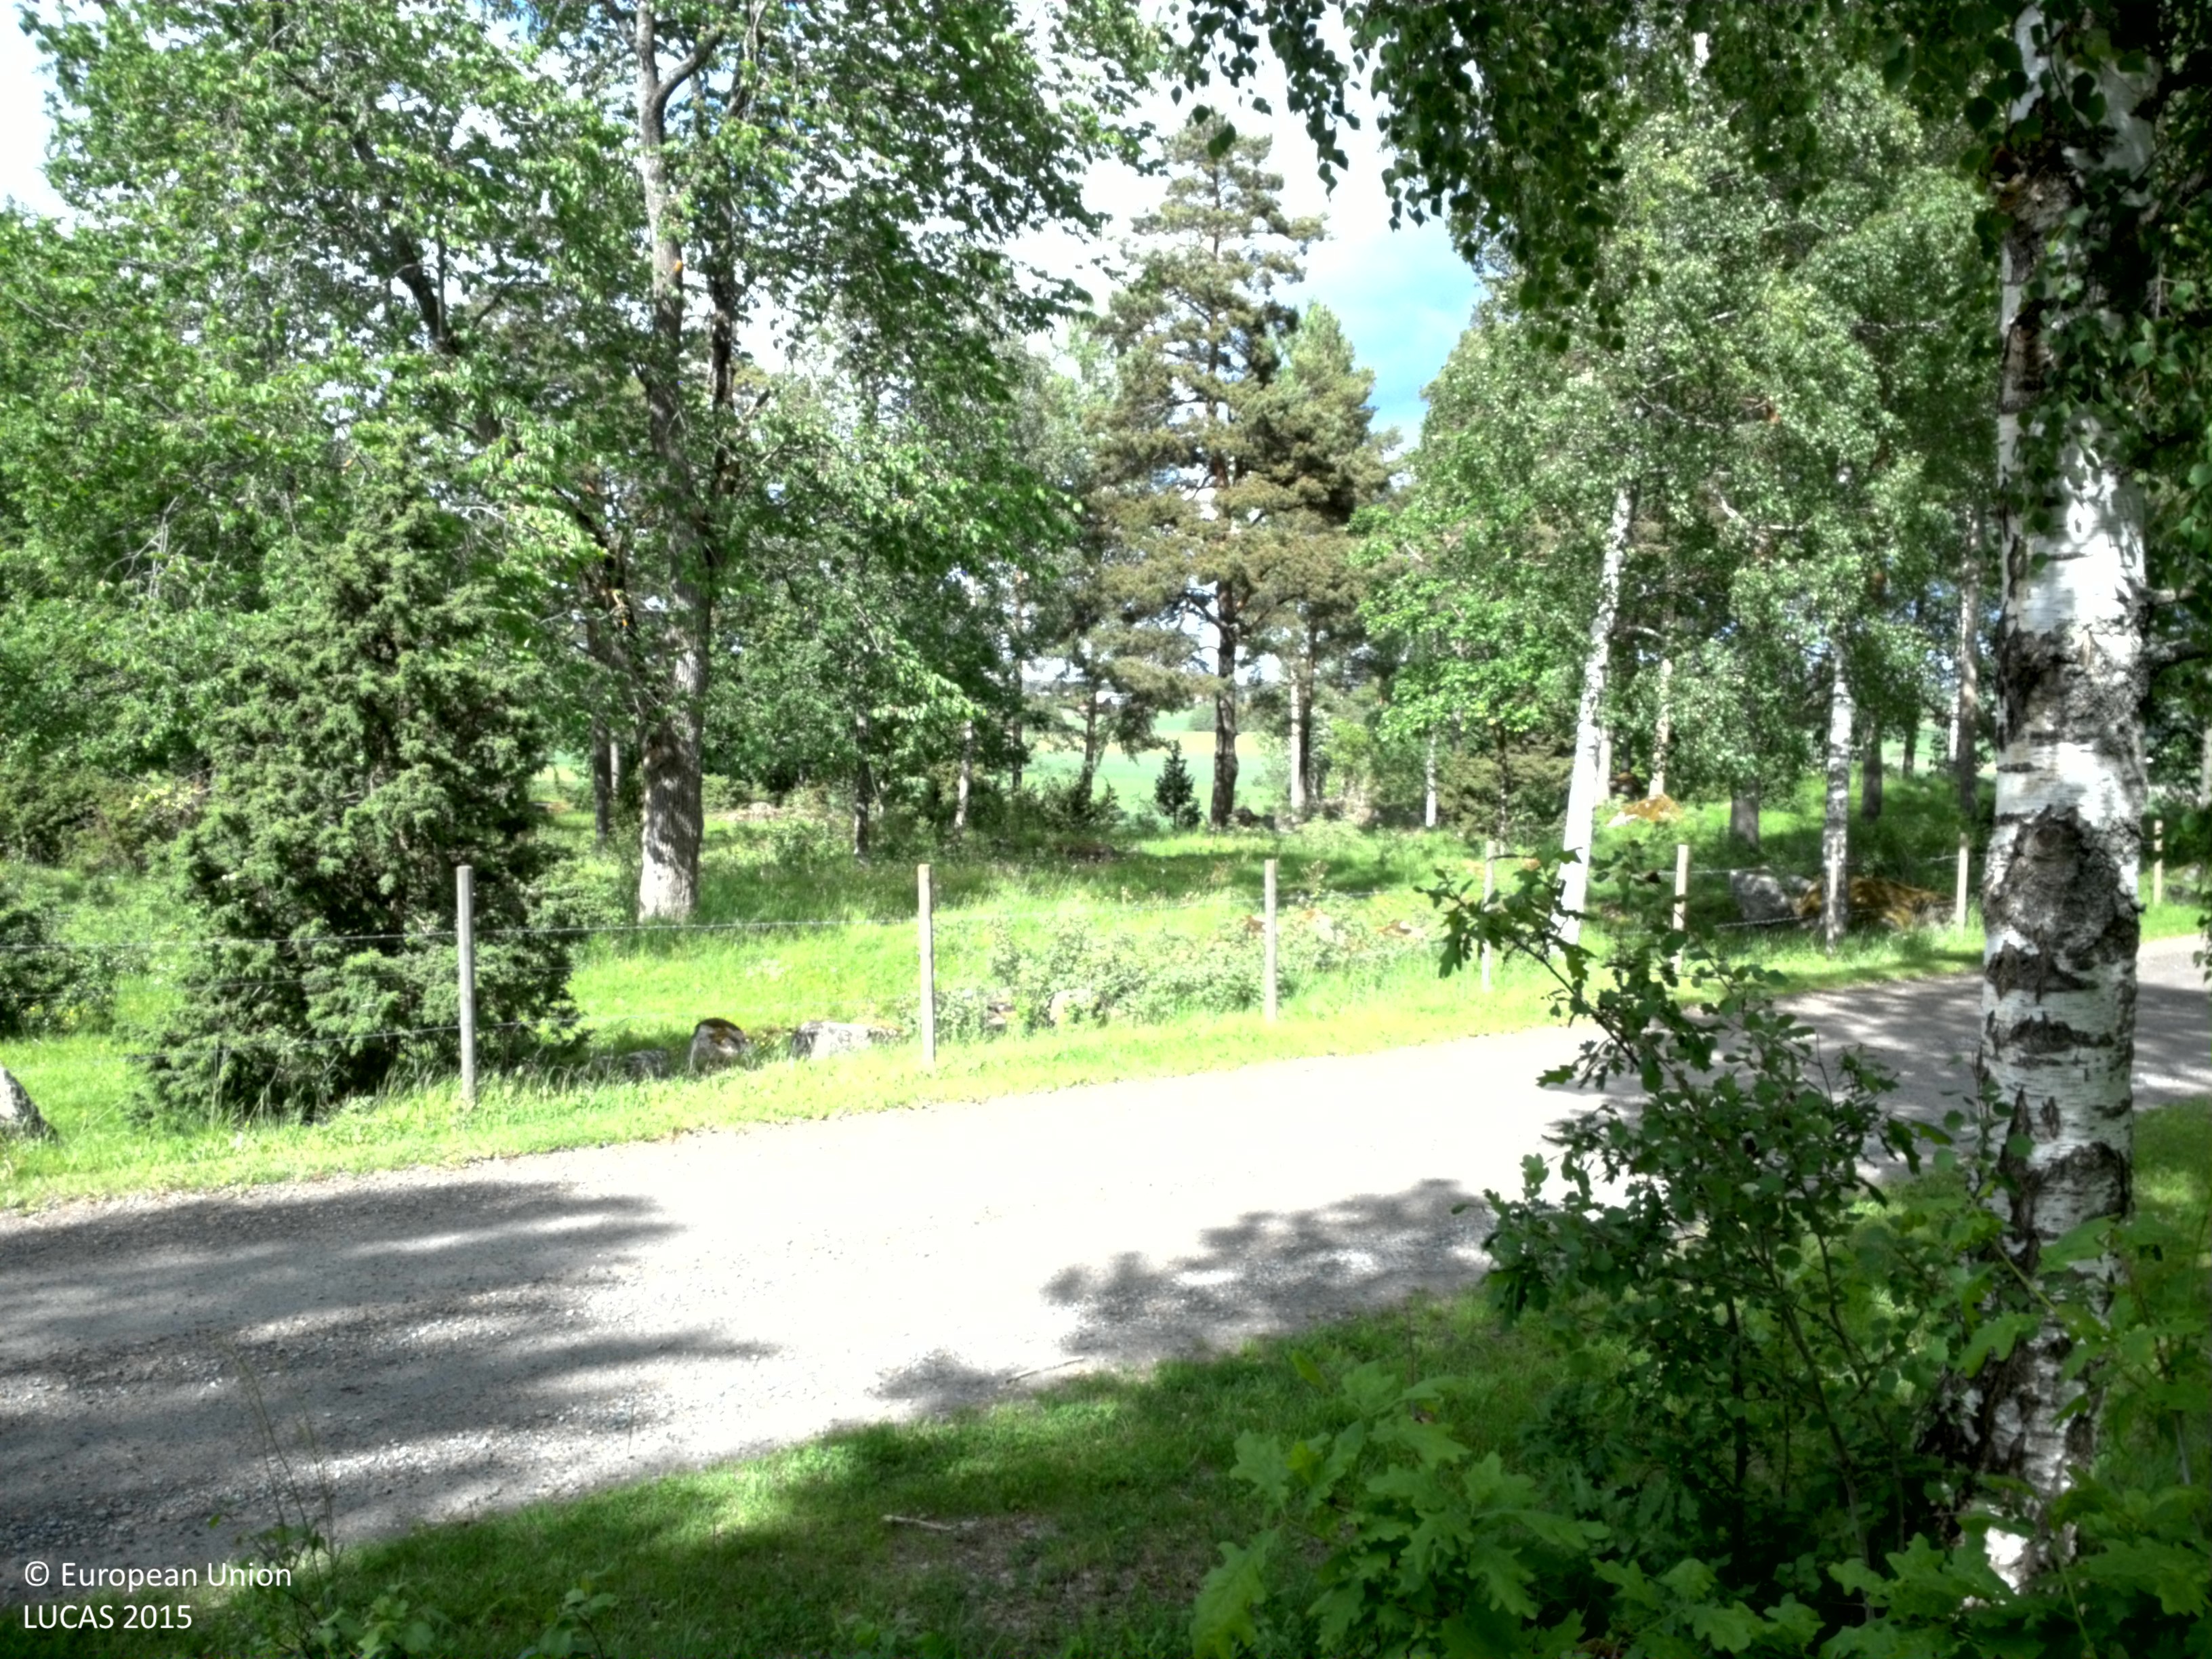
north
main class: Woodland
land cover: Broadleaved woodland
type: boreal forest
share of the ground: 25 - 50 %
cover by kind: broadleaved forest trees 40 %, herbaceous plants 30 %, coniferous forest trees 10 %, shrubs 10 %, lichens and mosses 10 %
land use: Forestry
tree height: > 5 m
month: June
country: SE
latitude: 59.8877
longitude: 17.5528
